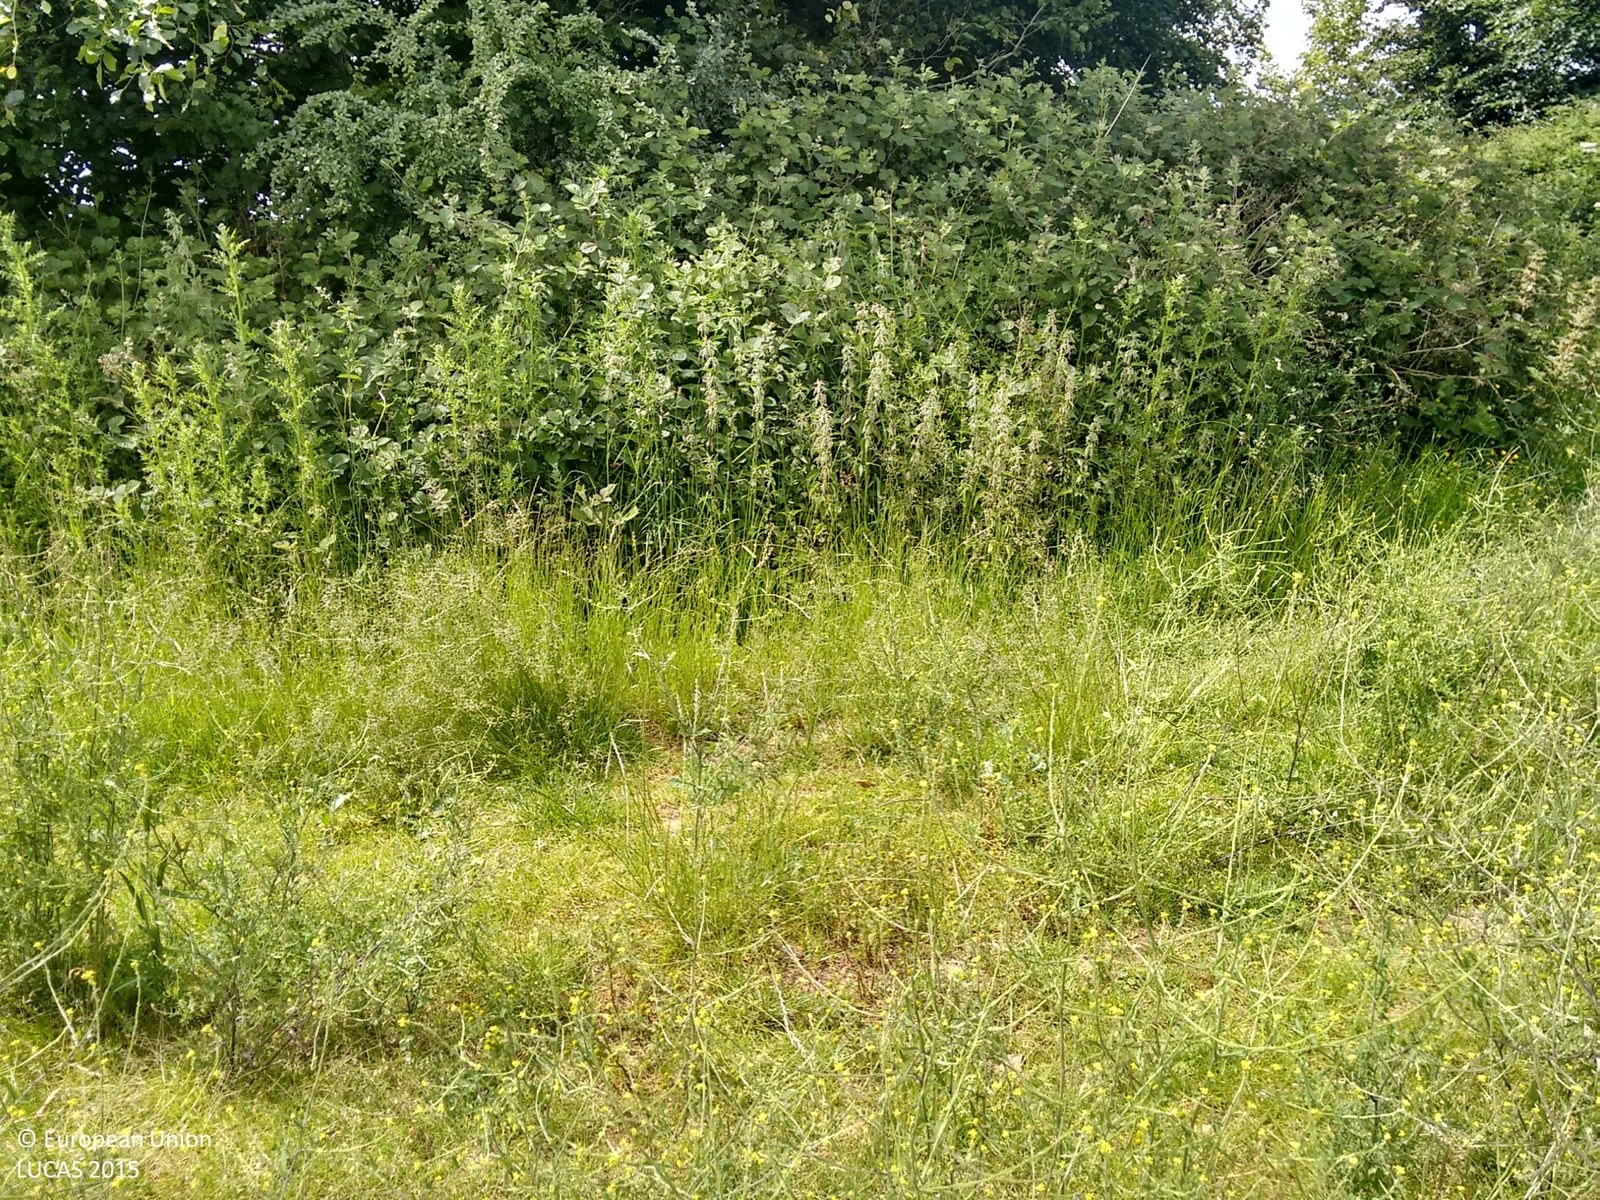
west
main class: Cropland
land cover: Common wheat
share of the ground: > 75 %
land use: Agriculture (excluding fallow land and kitchen gardens)
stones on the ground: > 50 %
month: June
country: GB
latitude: 52.0508
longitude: -2.0607
